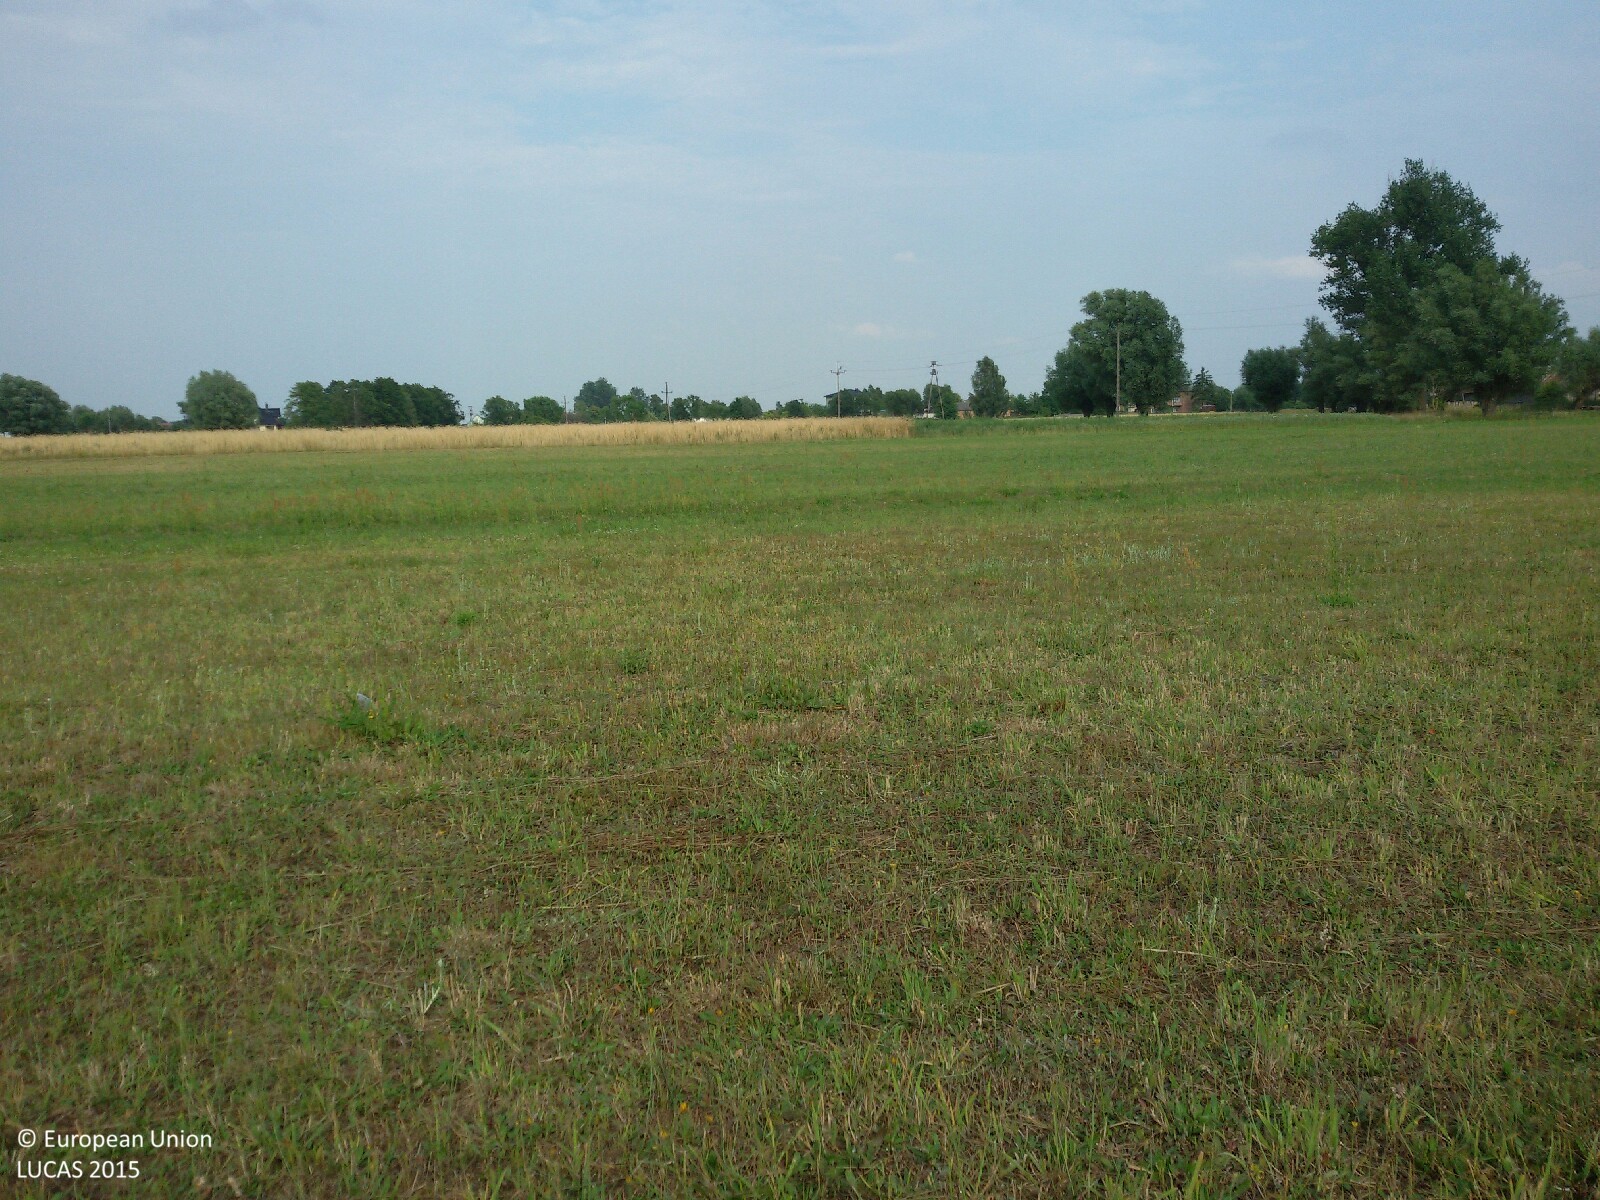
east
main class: Grassland
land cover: Grassland without tree/shrub cover
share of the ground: > 75 %
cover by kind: herbaceous plants 100 %
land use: Agriculture (excluding fallow land and kitchen gardens)
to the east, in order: Grassland without tree/shrub cover; Rye; Potatoes; Grassland without tree/shrub cover
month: July
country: PL
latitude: 52.4258
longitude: 21.2088
